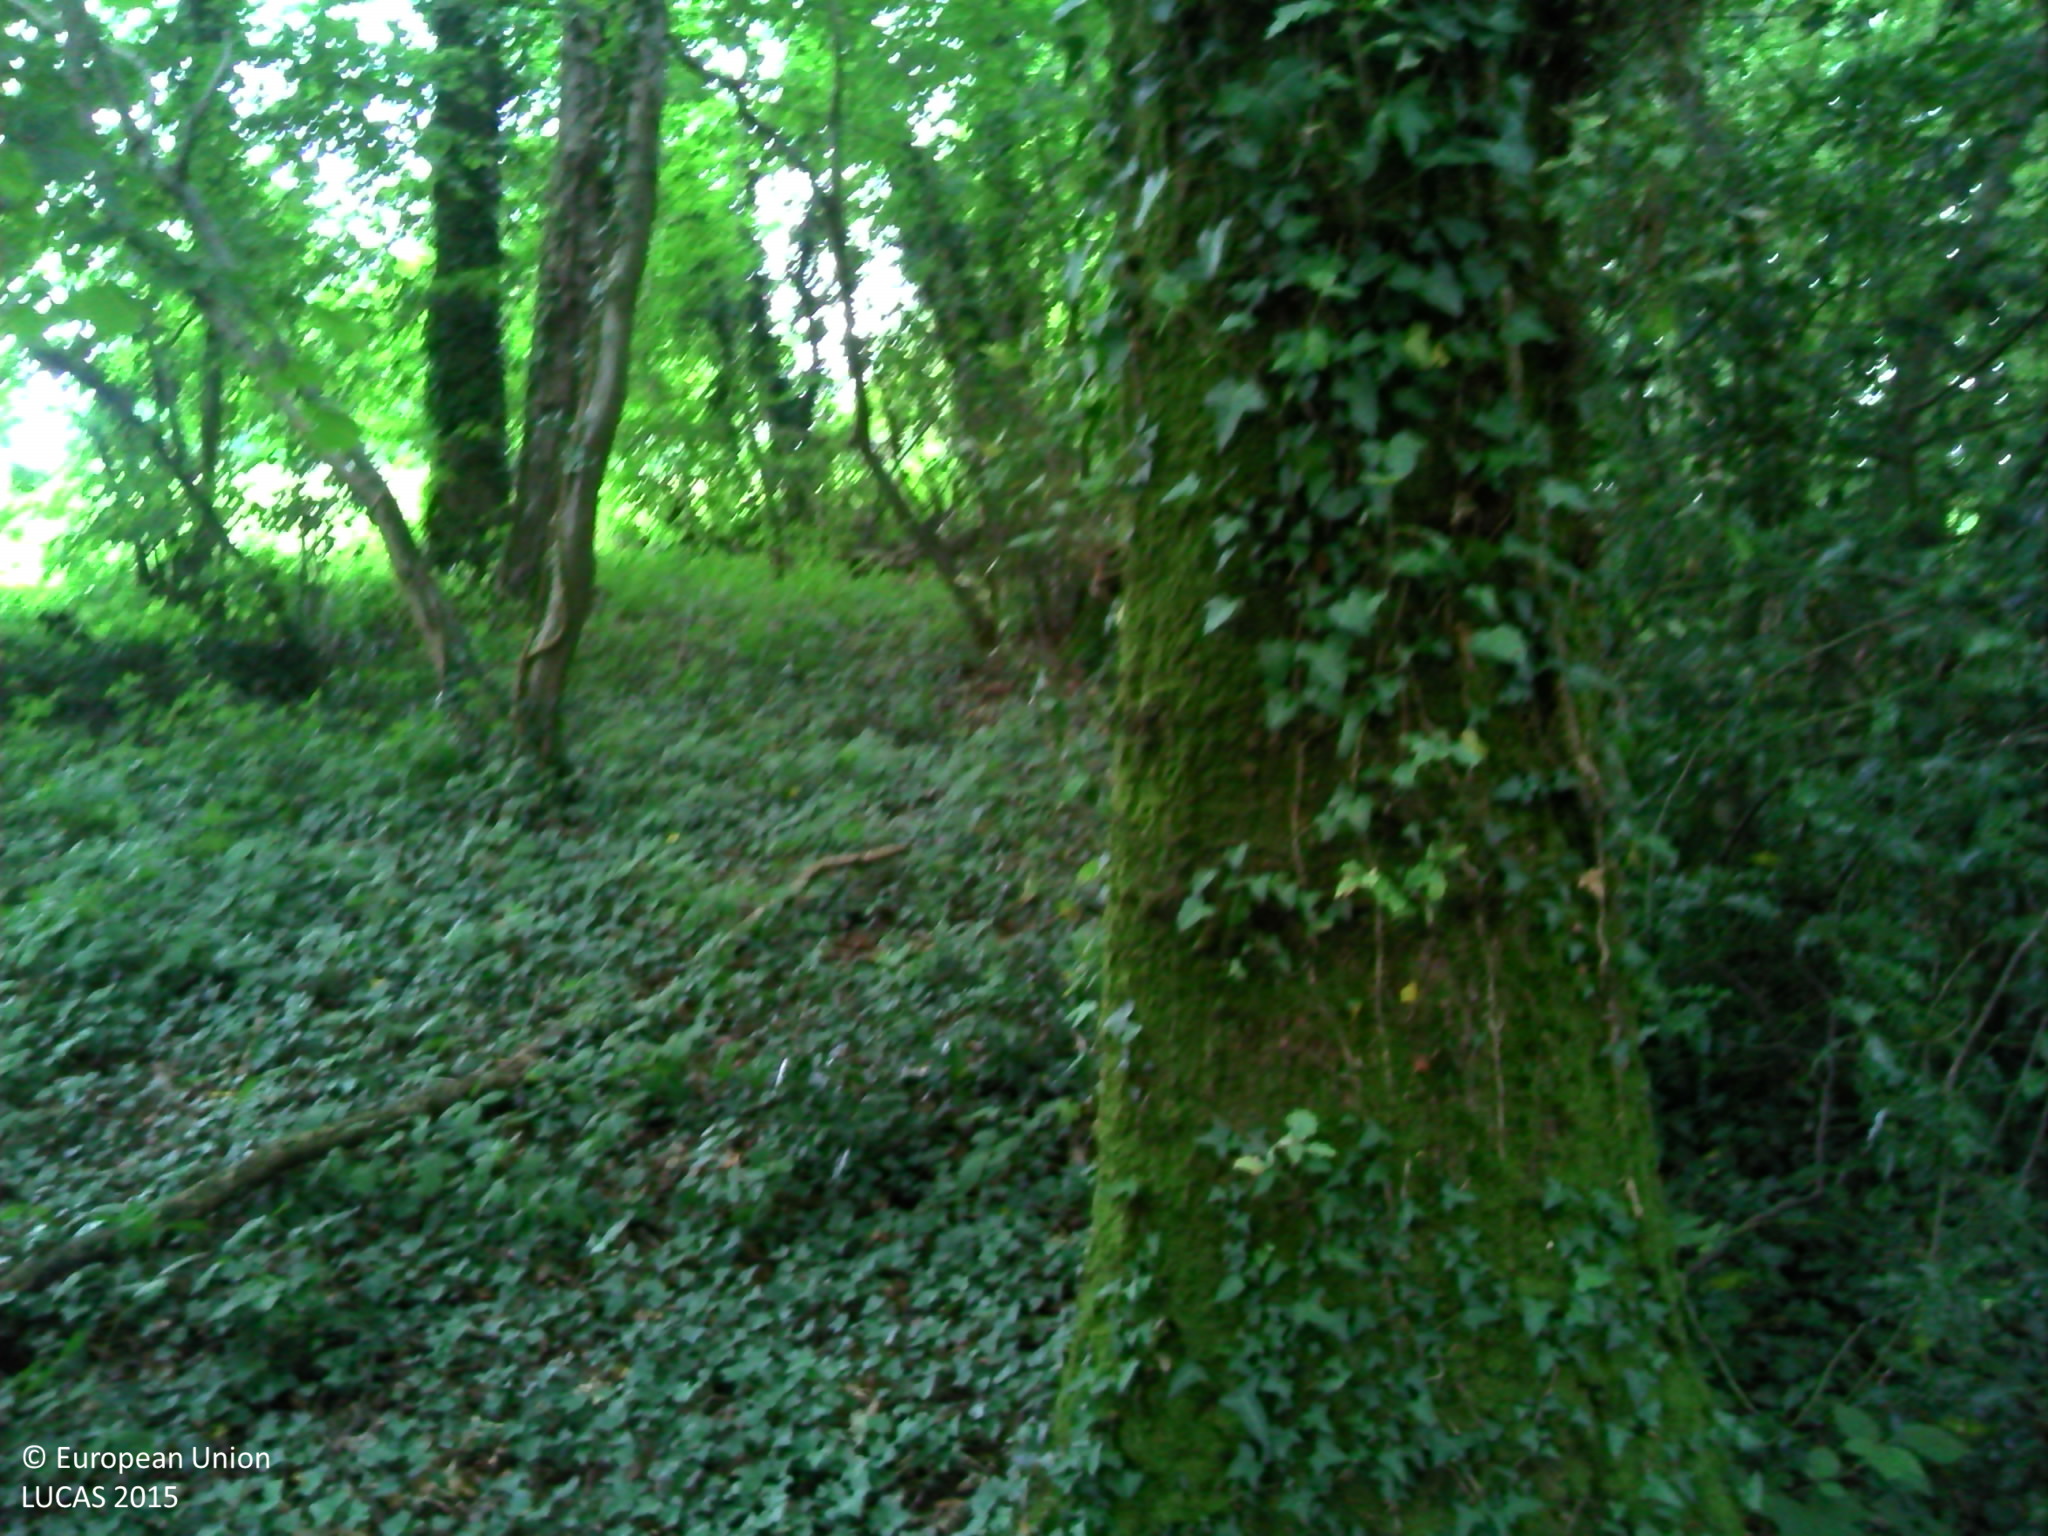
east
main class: Woodland
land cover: Broadleaved woodland
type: acidophilous oak and oak-birch forest
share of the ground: > 75 %
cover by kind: broadleaved forest trees 100 %
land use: Forestry
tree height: > 5 m
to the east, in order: Broadleaved woodland; Fences; Grassland without tree/shrub cover; Fences; Grassland without tree/shrub cover; Fences; Broadleaved woodland; Fences; Grassland without tree/shrub cover; Fences; Broadleaved woodland; Tracks; Broadleaved woodland; Fences; Grassland without tree/shrub cover; Fences; Broadleaved woodland; Grassland without tree/shrub cover; Managed hedges
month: July
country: FR
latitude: 48.9323
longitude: -1.2796
